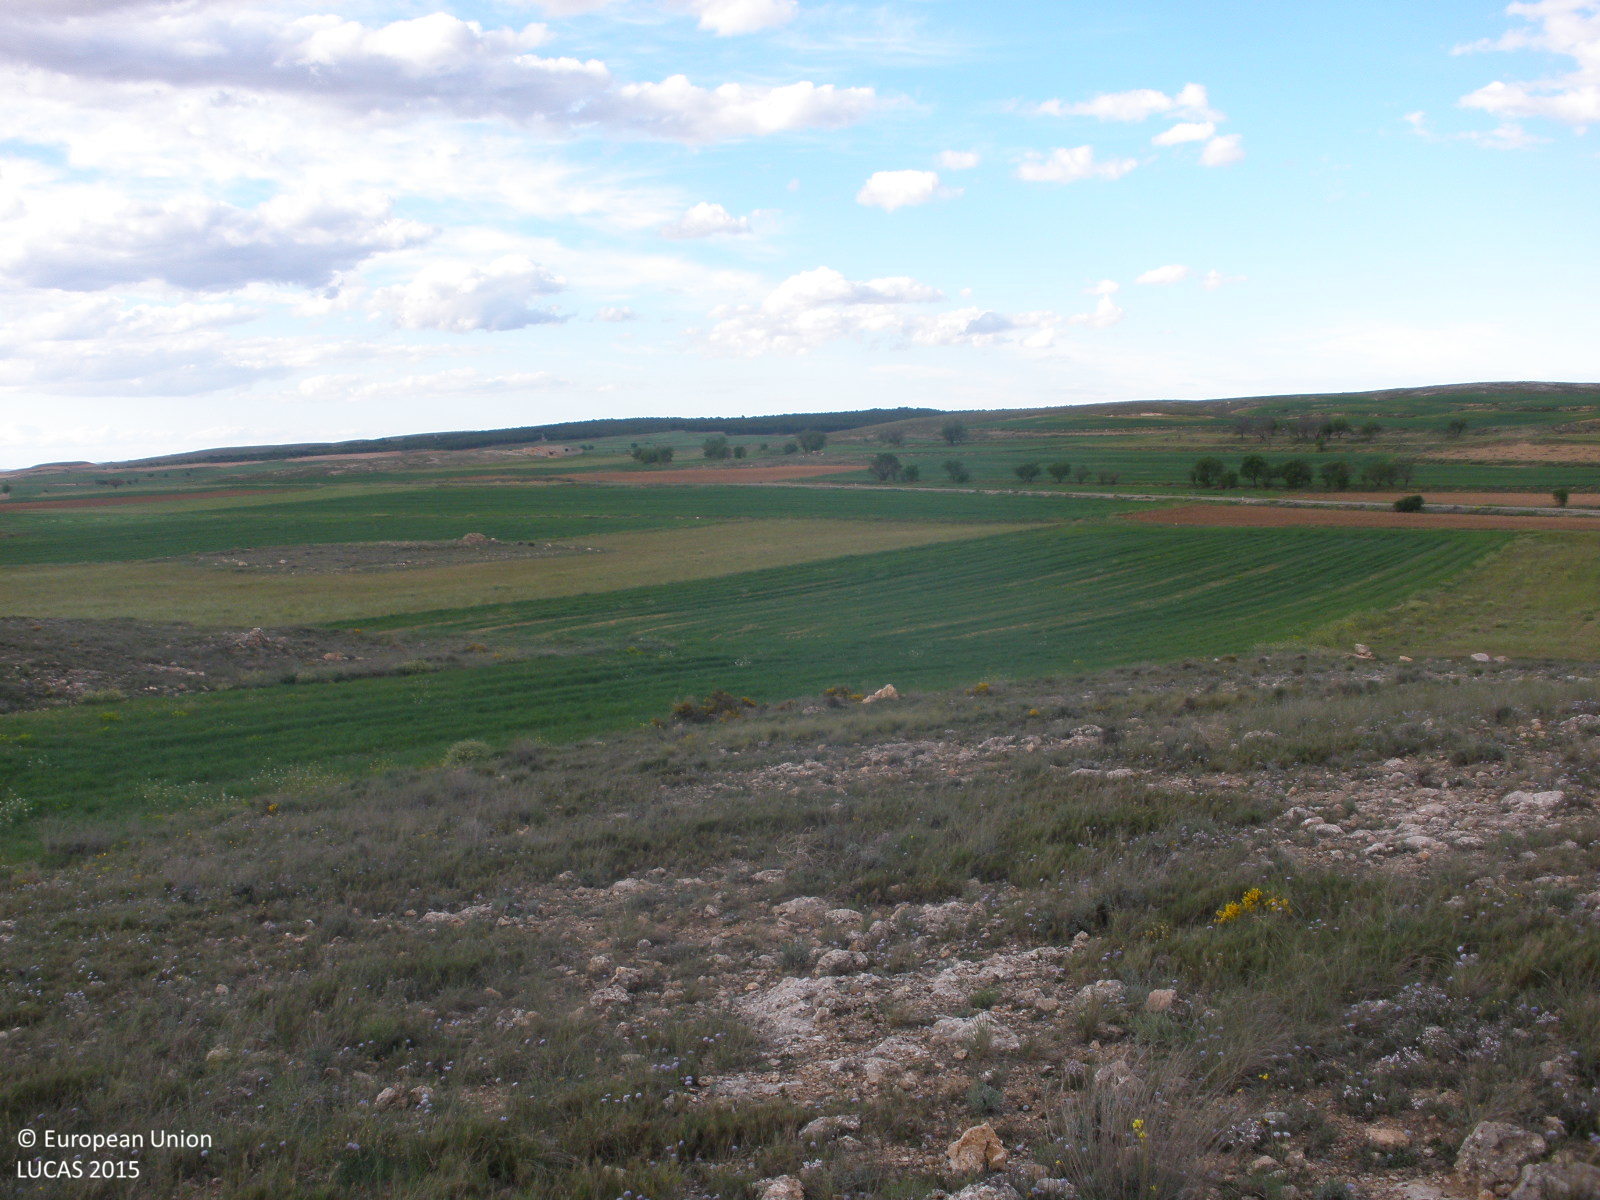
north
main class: Shrubland
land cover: Shrubland without tree cover
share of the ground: 25 - 50 %
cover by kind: herbaceous plants 50 %, shrubs 30 %, consolidated bare surface 20 %
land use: Agriculture (excluding fallow land and kitchen gardens)
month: May
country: ES
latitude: 41.0795
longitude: -0.9077
